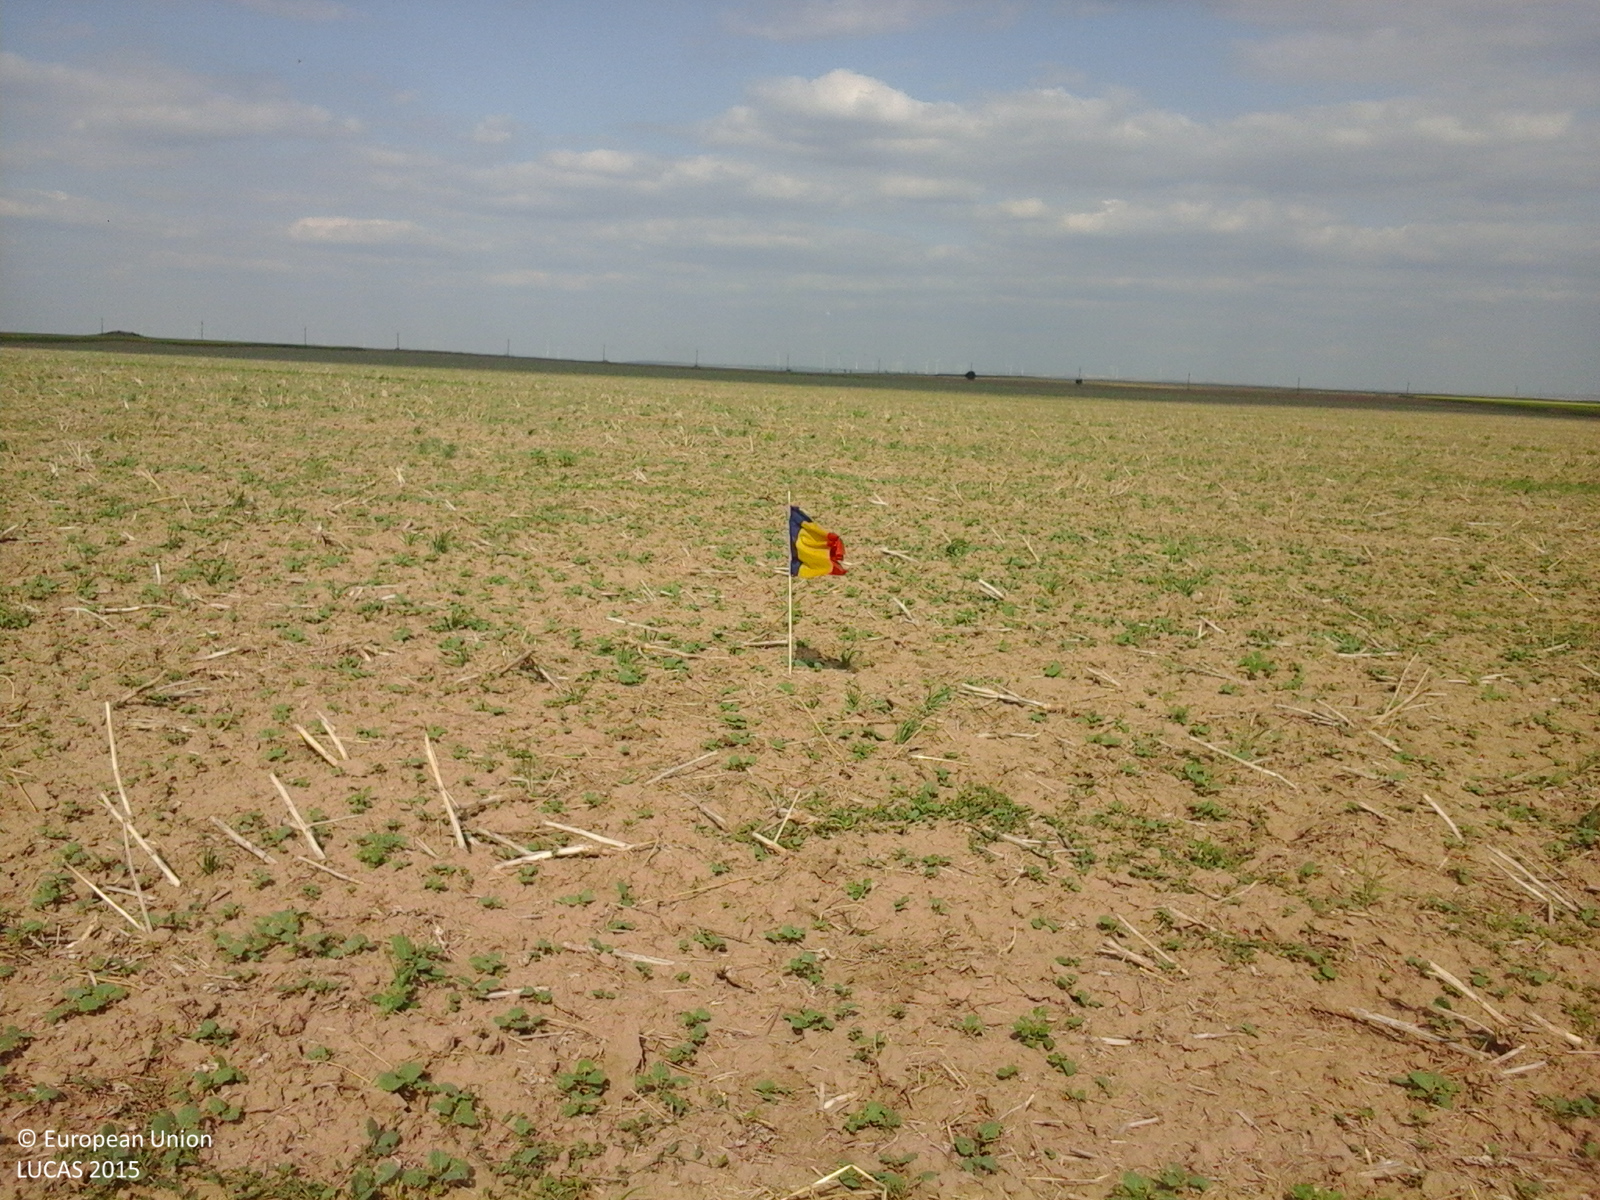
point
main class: Cropland
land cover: Rape and turnip rape
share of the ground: 10 - 25 %
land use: Agriculture (excluding fallow land and kitchen gardens)
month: August
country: RO
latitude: 44.7510
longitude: 28.1133
